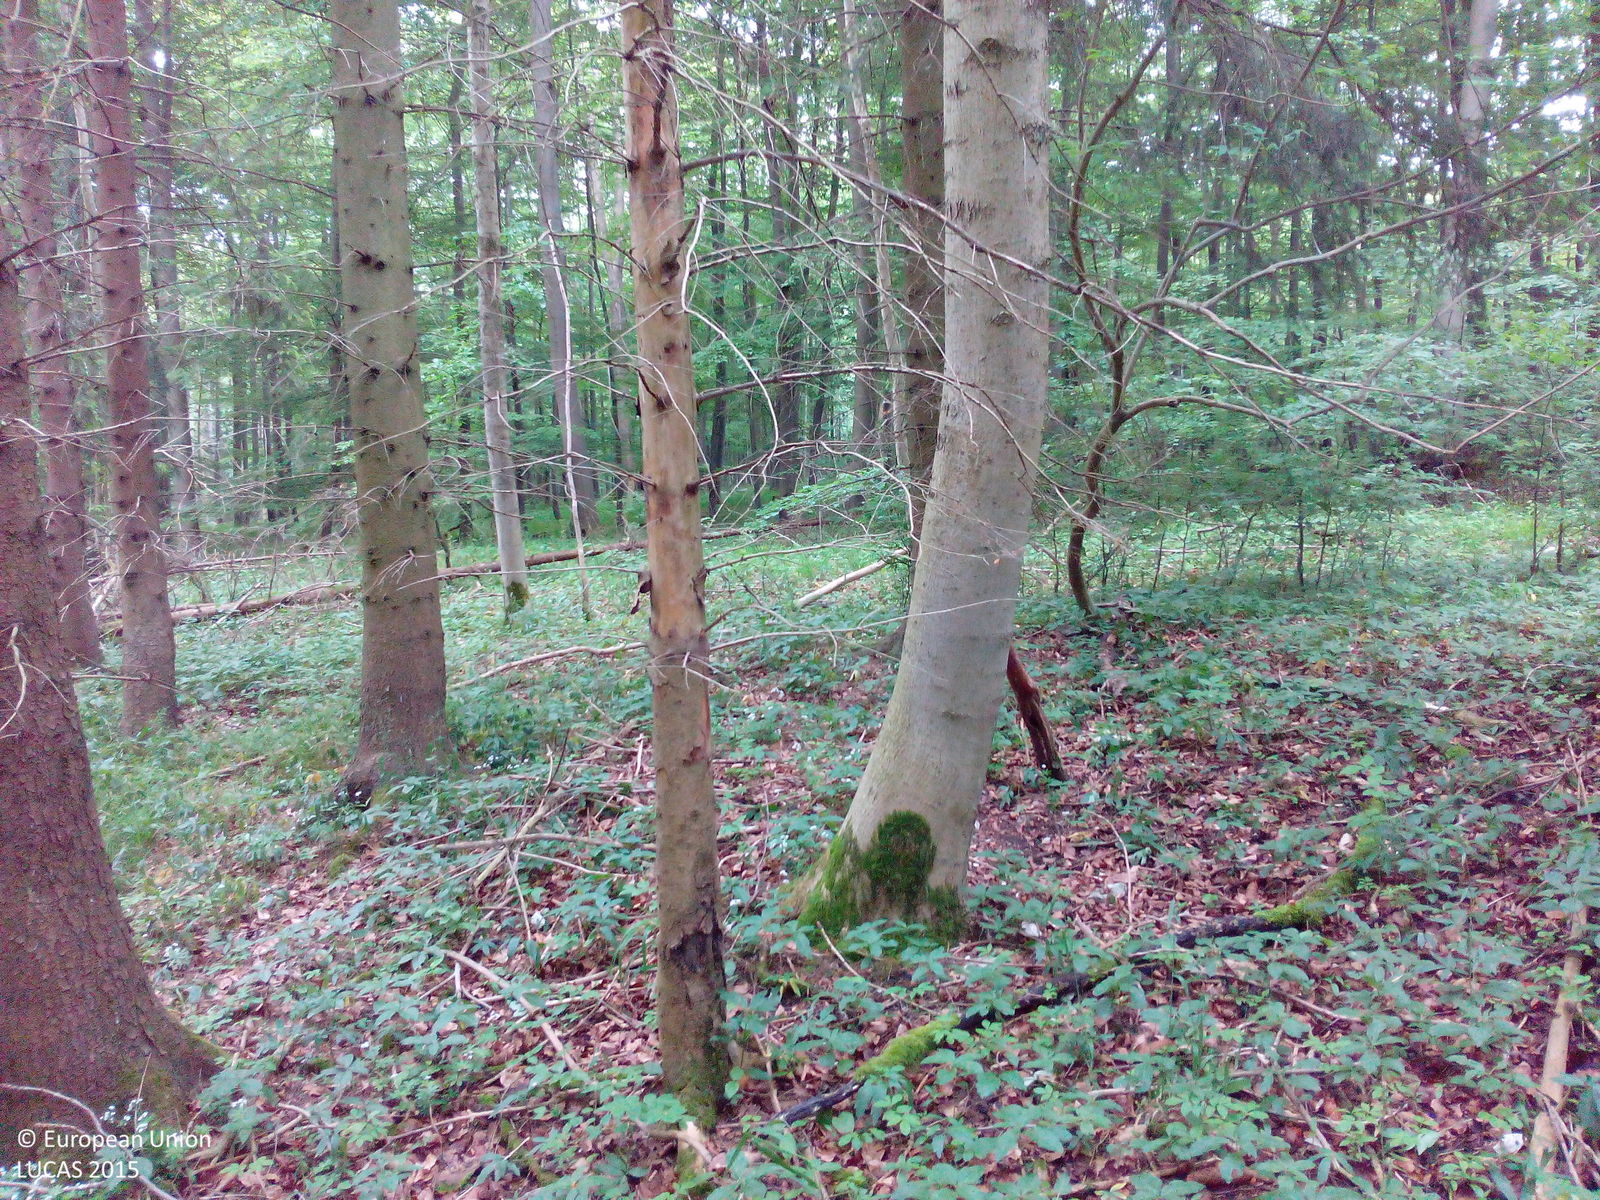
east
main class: Woodland
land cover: Spruce dominated coniferous woodland
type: hemiboreal forest and nemoral coniferous forest and mixed broadleaved-coniferous forest
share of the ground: > 75 %
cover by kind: coniferous forest trees 80 %, broadleaved forest trees 15 %, shrubs 5 %
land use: Forestry
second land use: Amenities, museums, leisure
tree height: > 5 m
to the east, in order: Spruce dominated coniferous woodland; Tracks; Broadleaved woodland; Tracks; Broadleaved woodland
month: May
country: DE
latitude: 51.9820
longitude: 9.8981
